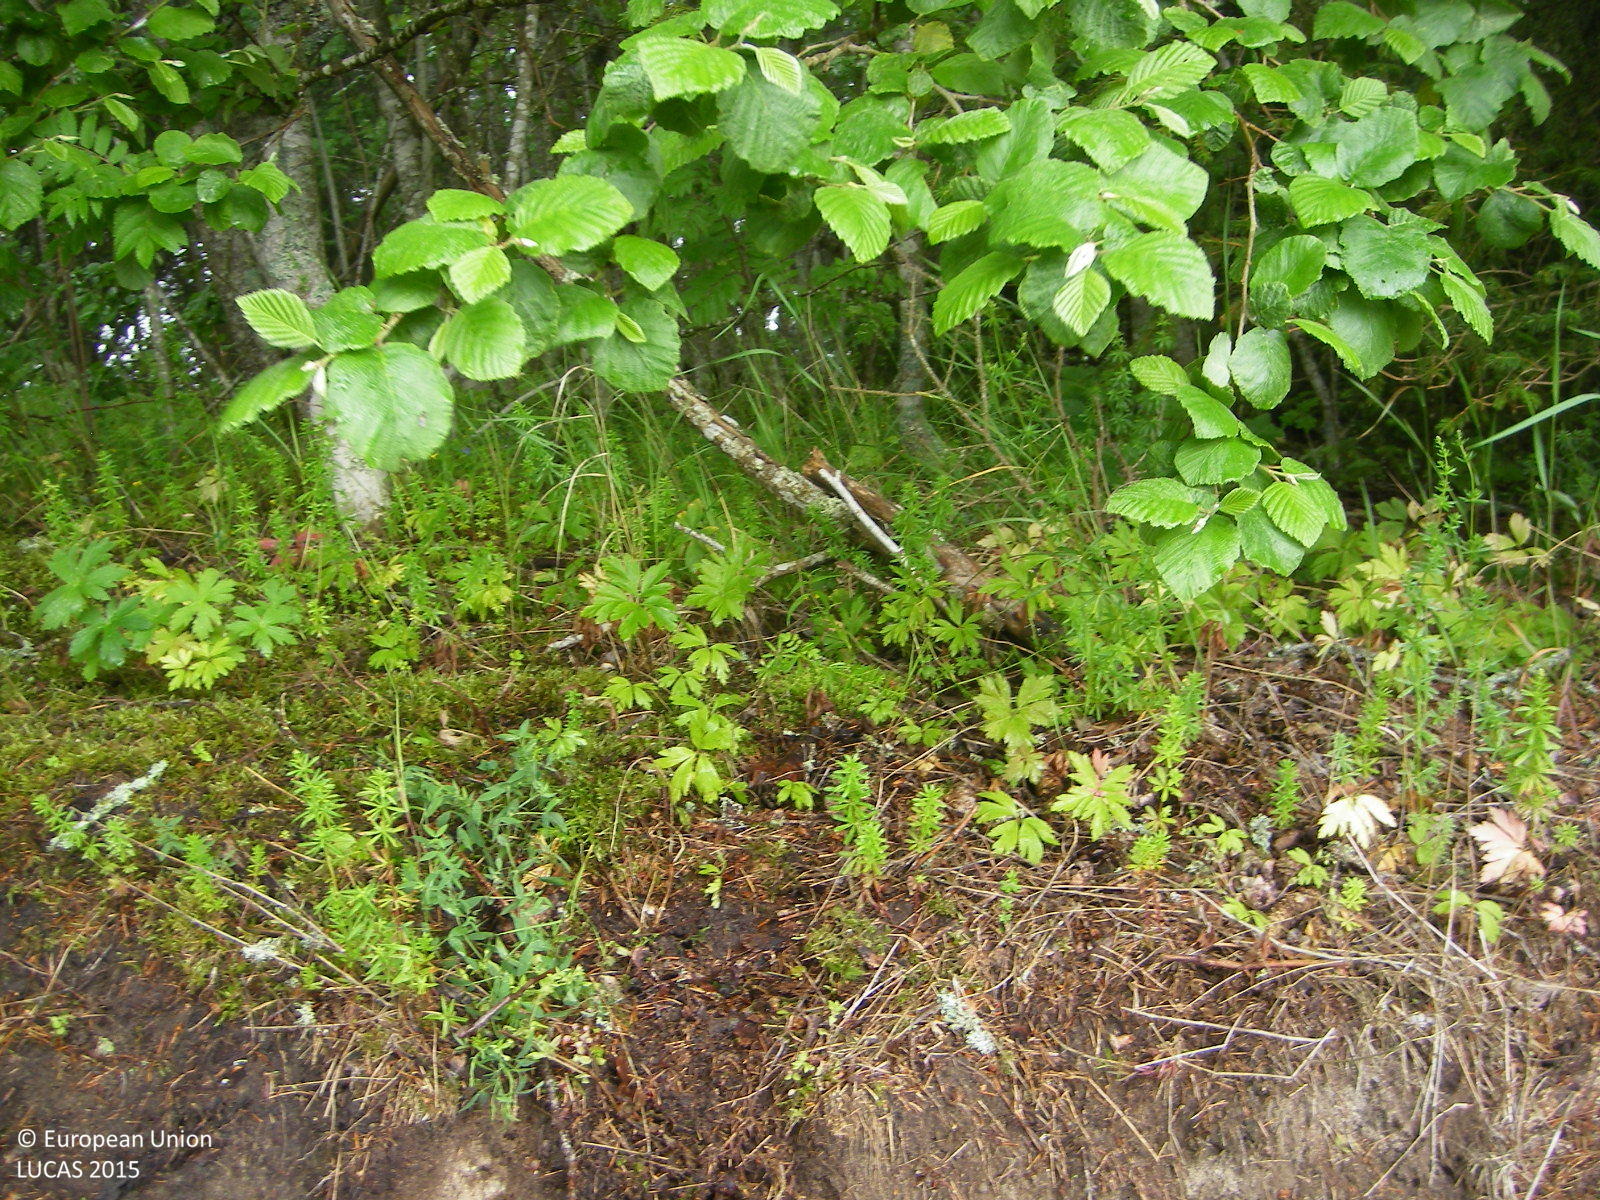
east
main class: Cropland
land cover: Rape and turnip rape
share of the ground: < 10 %
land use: Agriculture (excluding fallow land and kitchen gardens)
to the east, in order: Rape and turnip rape; Ditches and canals; Other mixed woodland; Ditches and canals; Grass margins; Paved roads, cycling and walking lanes; Grass margins; Ditches and canals; Common wheat
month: June
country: FI
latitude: 60.4230
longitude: 23.3246
